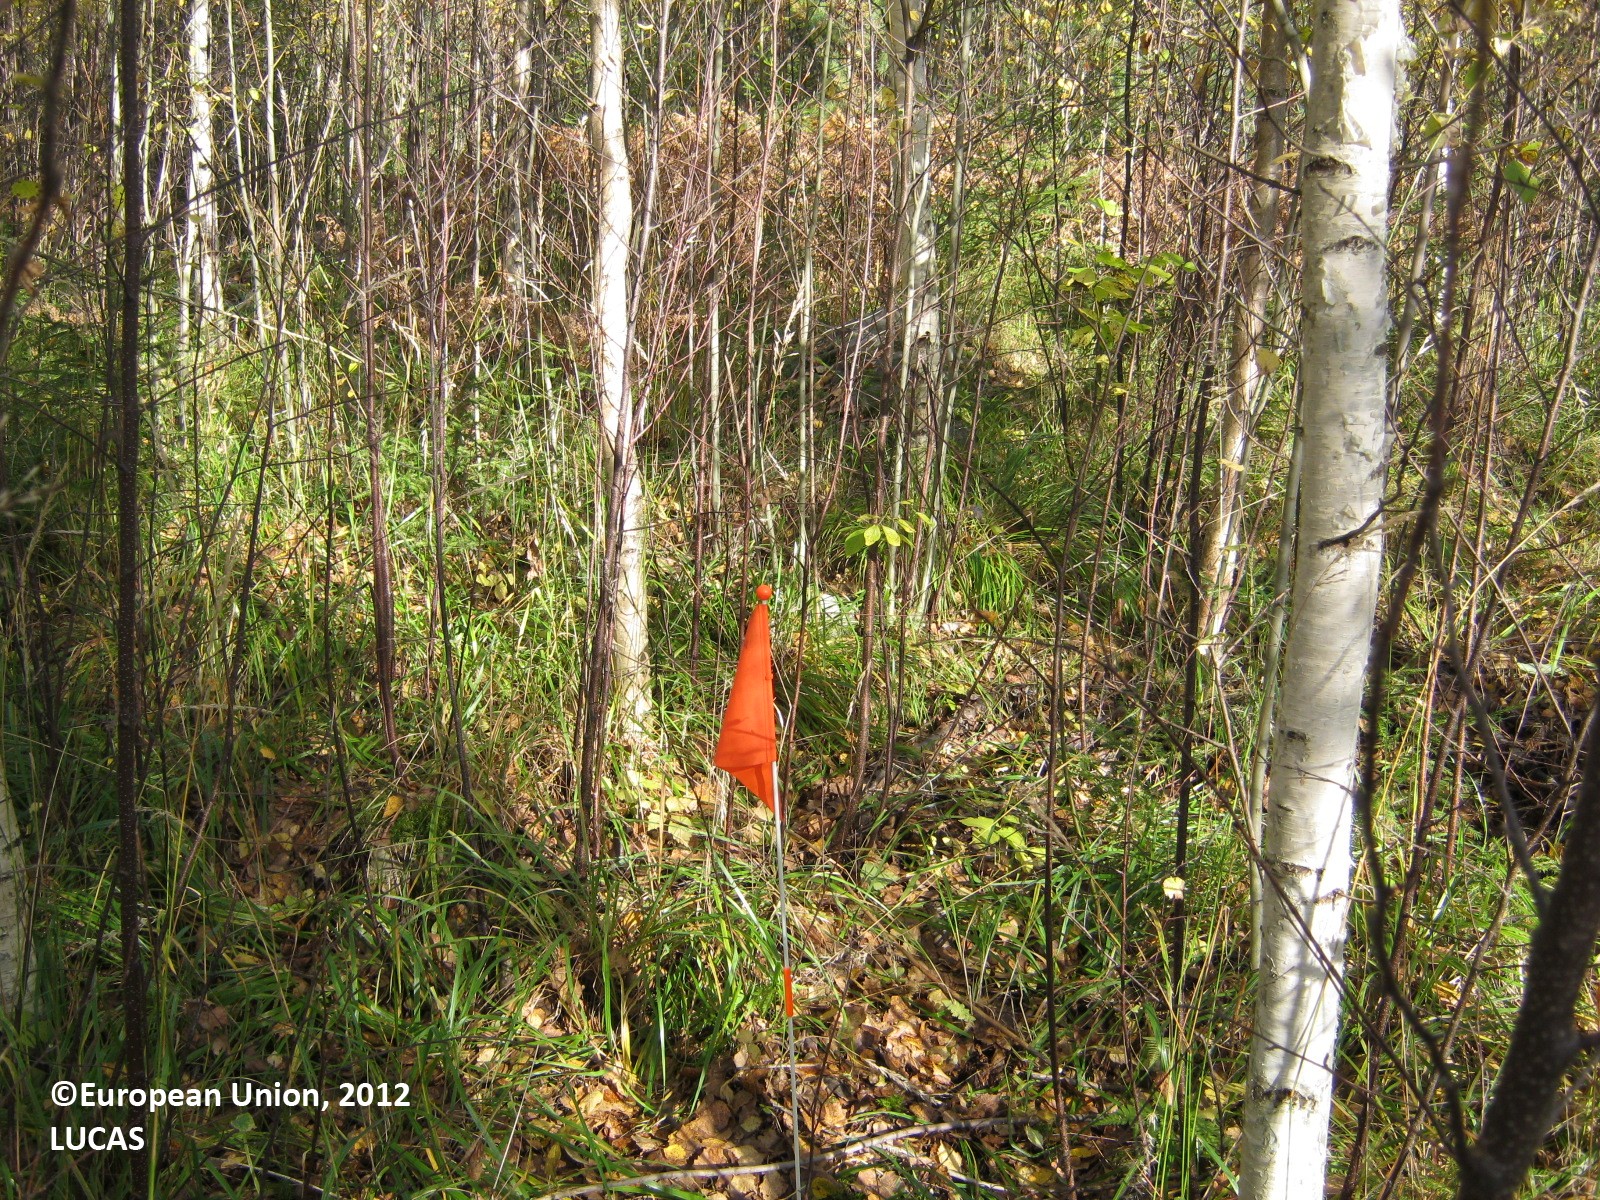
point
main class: Woodland
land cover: Broadleaved woodland
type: boreal forest
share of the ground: > 75 %
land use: Forestry
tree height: > 5 m
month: September
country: FI
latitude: 62.3973
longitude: 28.8052
